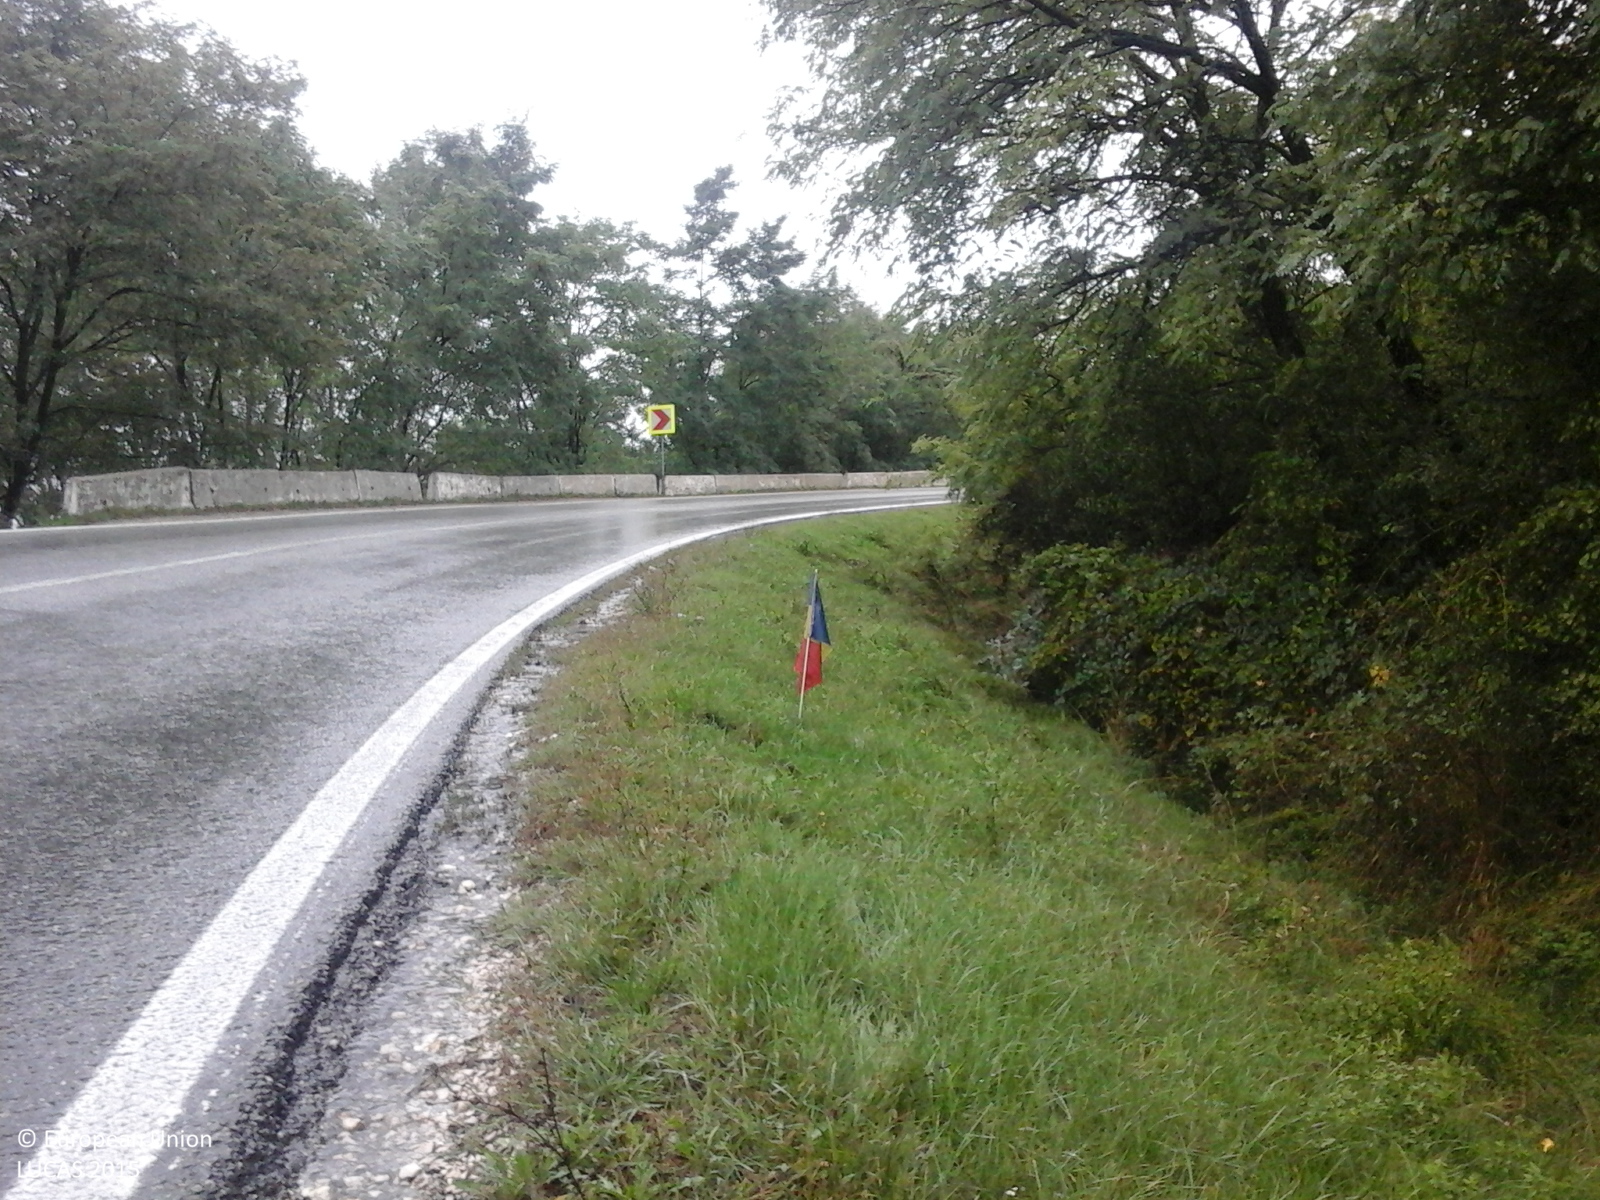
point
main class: Grassland
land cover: Grassland without tree/shrub cover
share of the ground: > 75 %
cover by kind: herbaceous plants 100 %
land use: Agriculture (excluding fallow land and kitchen gardens)
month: September
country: RO
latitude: 45.1430
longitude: 23.7855
